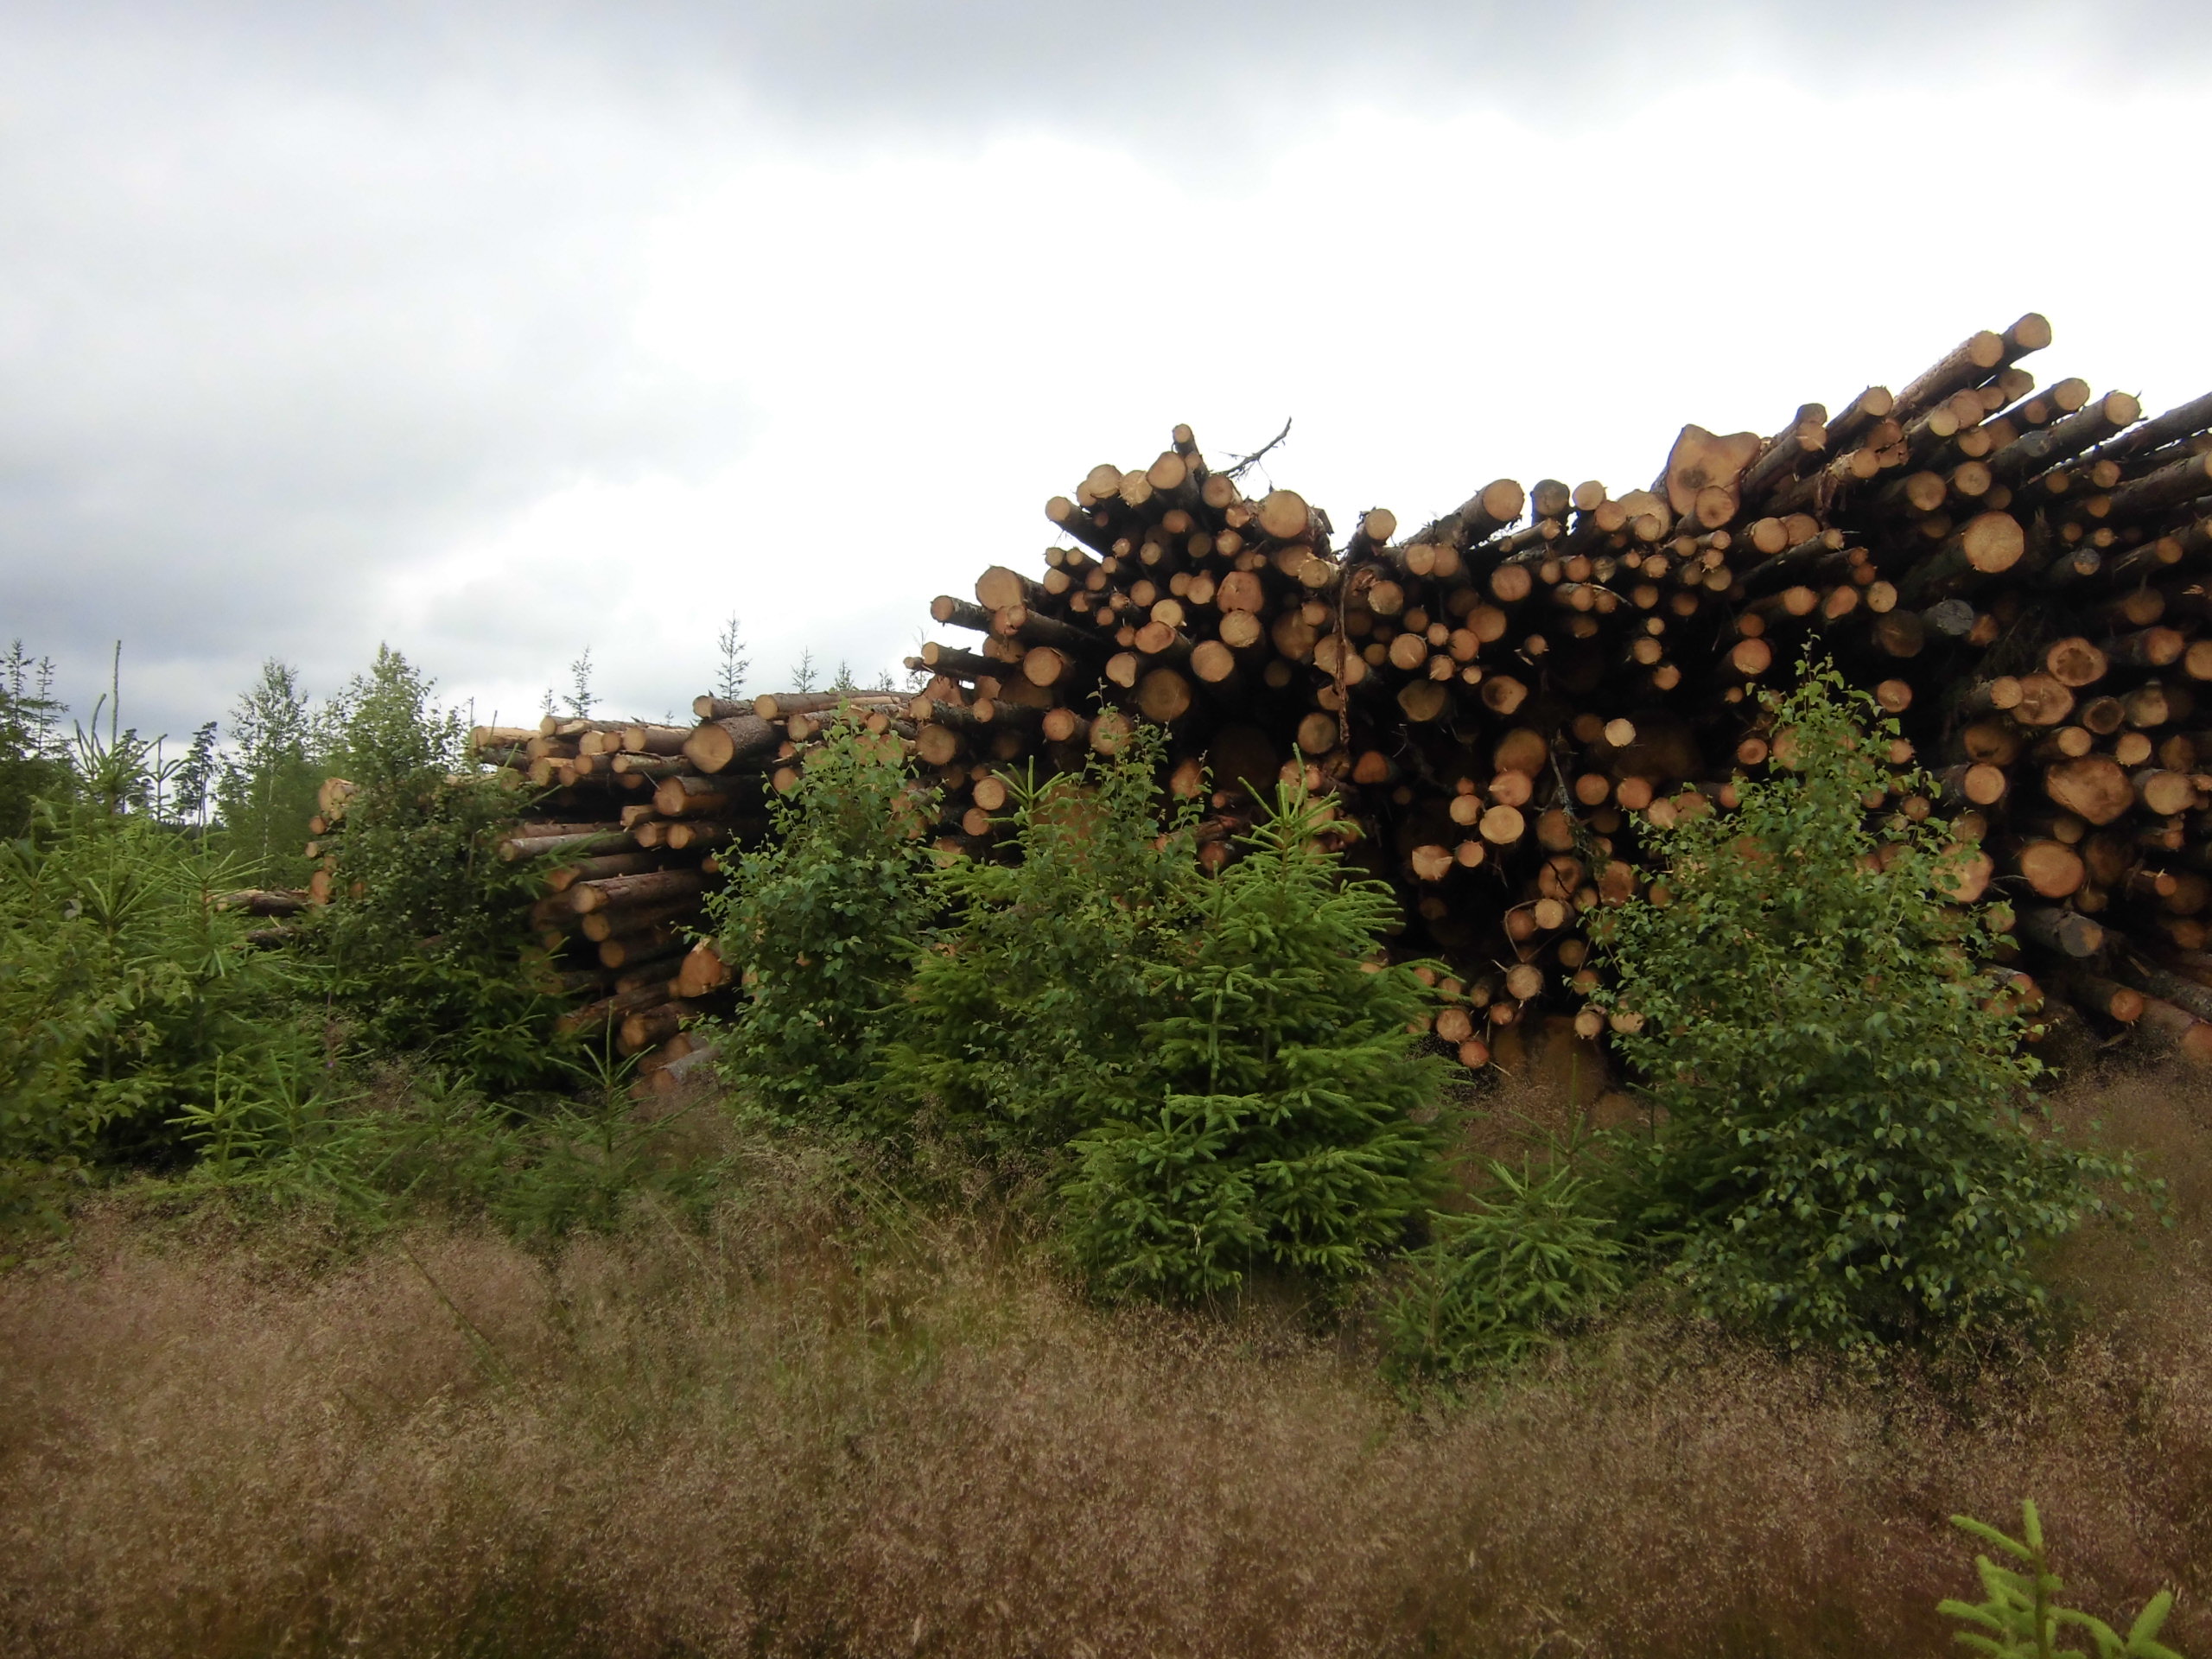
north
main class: Woodland
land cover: Spruce dominated mixed woodland
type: boreal forest
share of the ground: 25 - 50 %
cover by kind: herbaceous plants 45 %, broadleaved forest trees 15 %, coniferous forest trees 10 %, shrubs 10 %, lichens and mosses 10 %, unconsolidated bare surface 10 %
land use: Forestry
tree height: < 5 m
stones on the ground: 10 - 25 %
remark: Clear cut
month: July
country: SE
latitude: 57.4666
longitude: 14.8142
